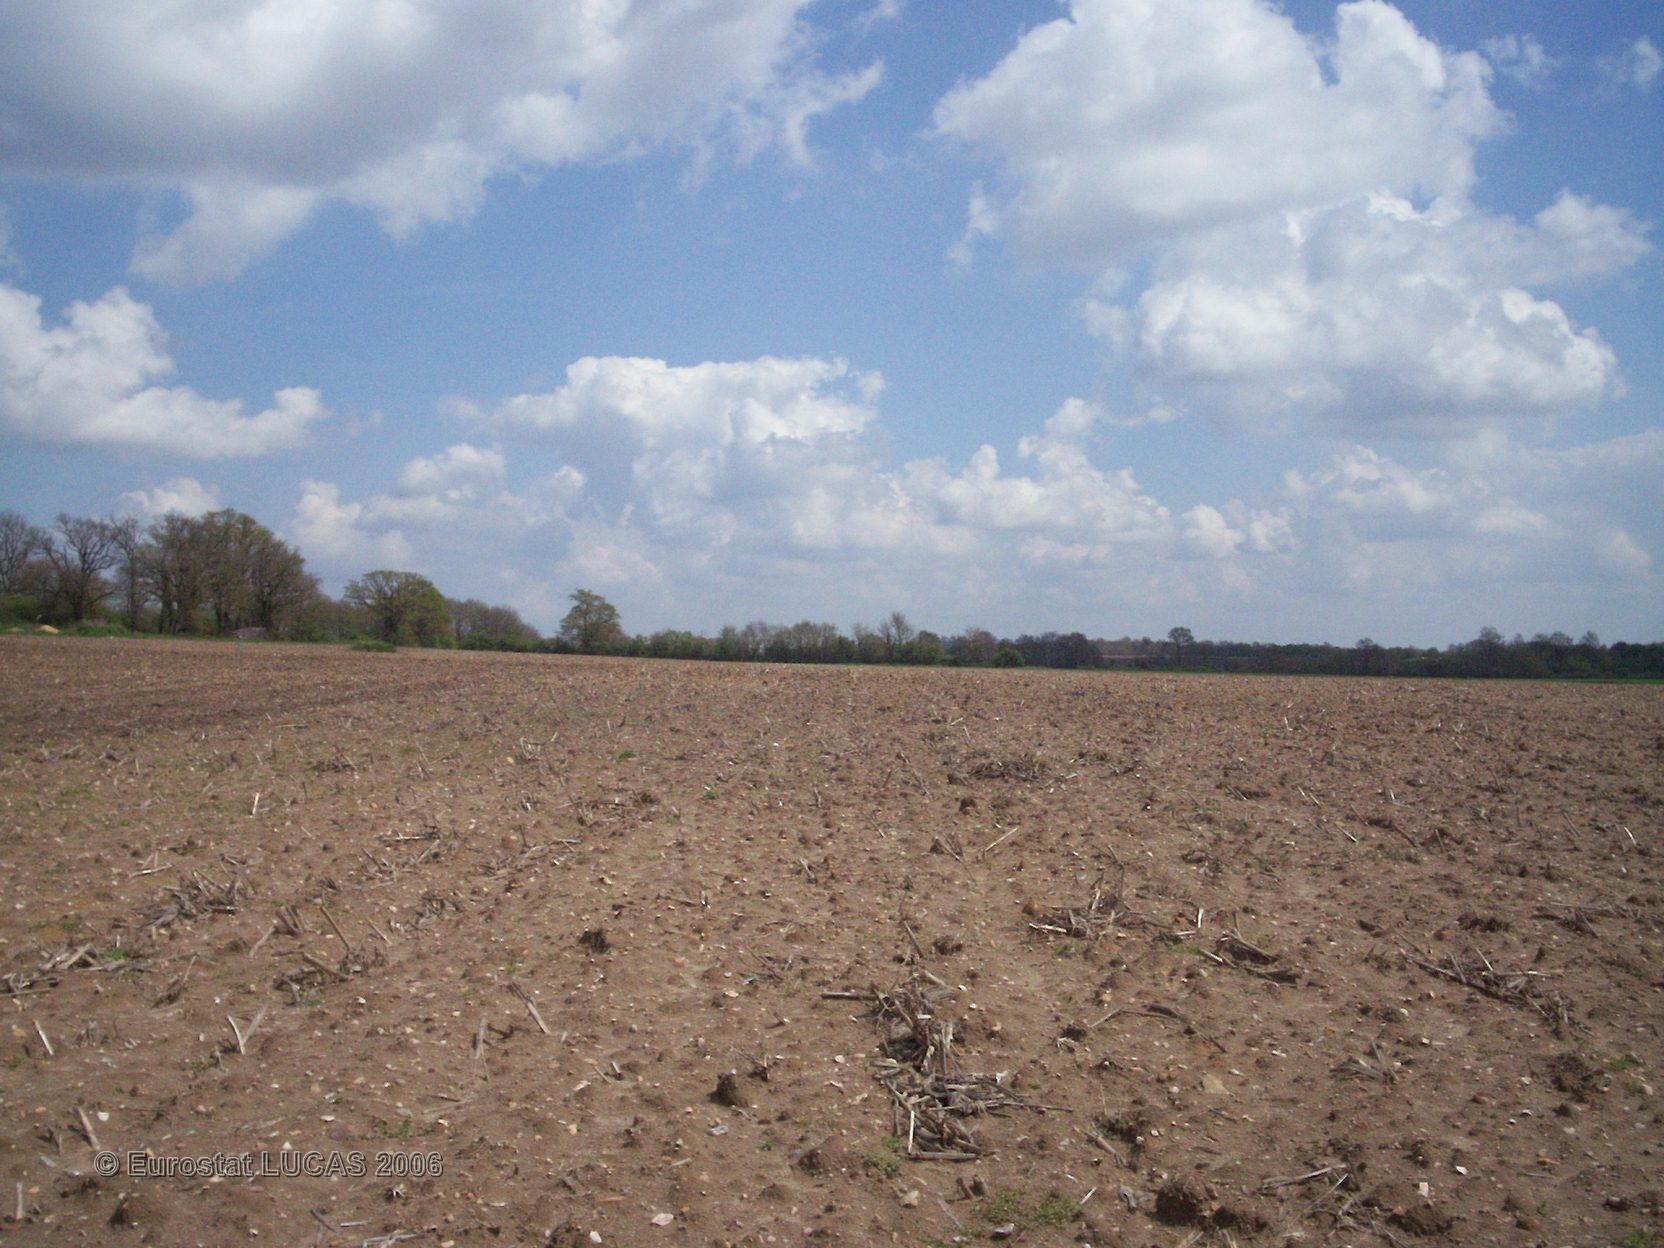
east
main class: Cropland
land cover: Maize
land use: Agriculture (excluding fallow land and kitchen gardens)
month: June
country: FR
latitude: 46.3098
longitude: 0.5174
